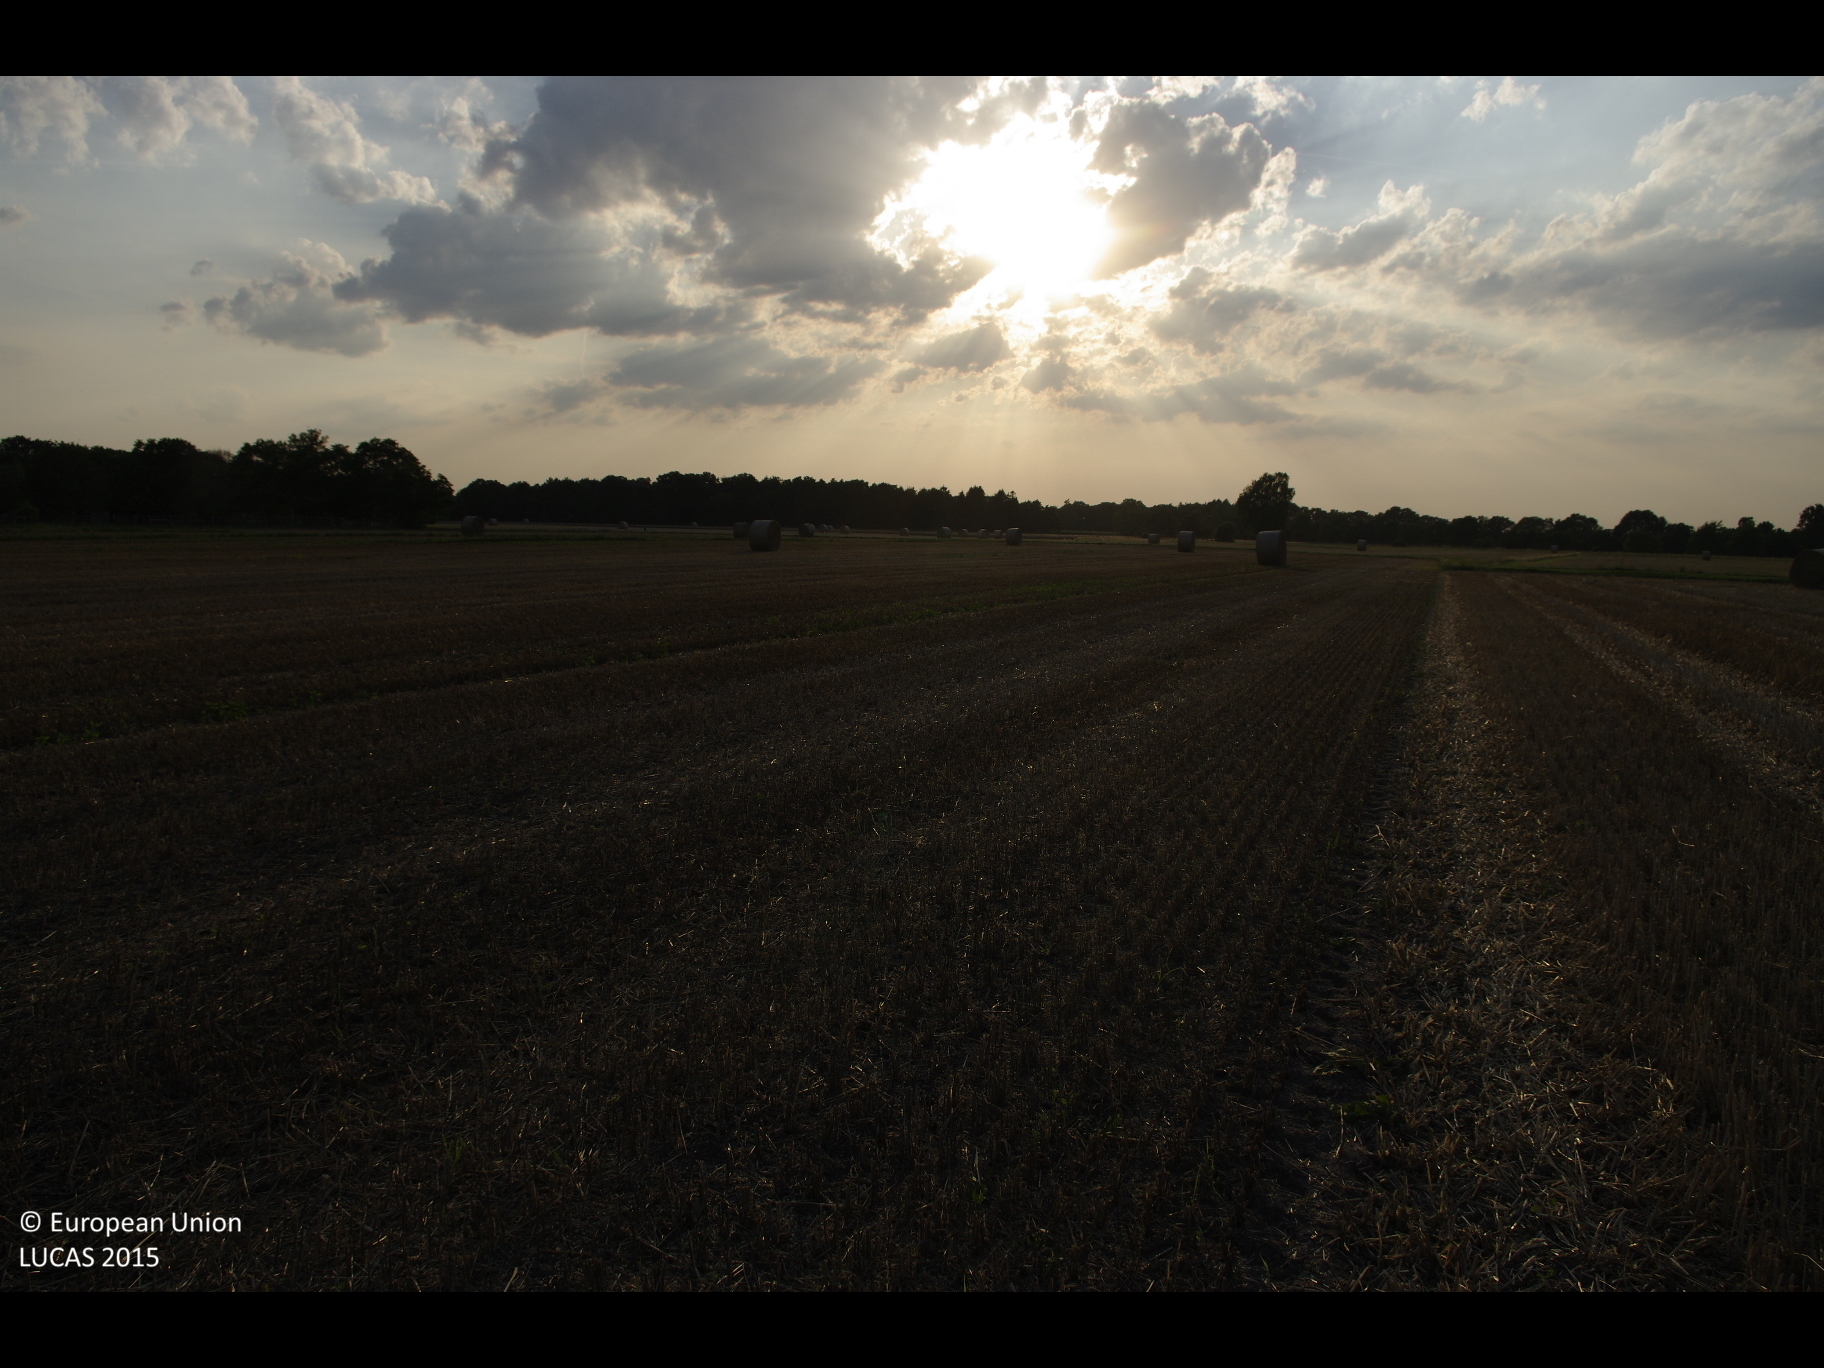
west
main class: Cropland
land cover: Rye
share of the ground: 50 - 75 %
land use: Agriculture (excluding fallow land and kitchen gardens)
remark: Harvested field
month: August
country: DE
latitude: 53.1682
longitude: 9.8355
